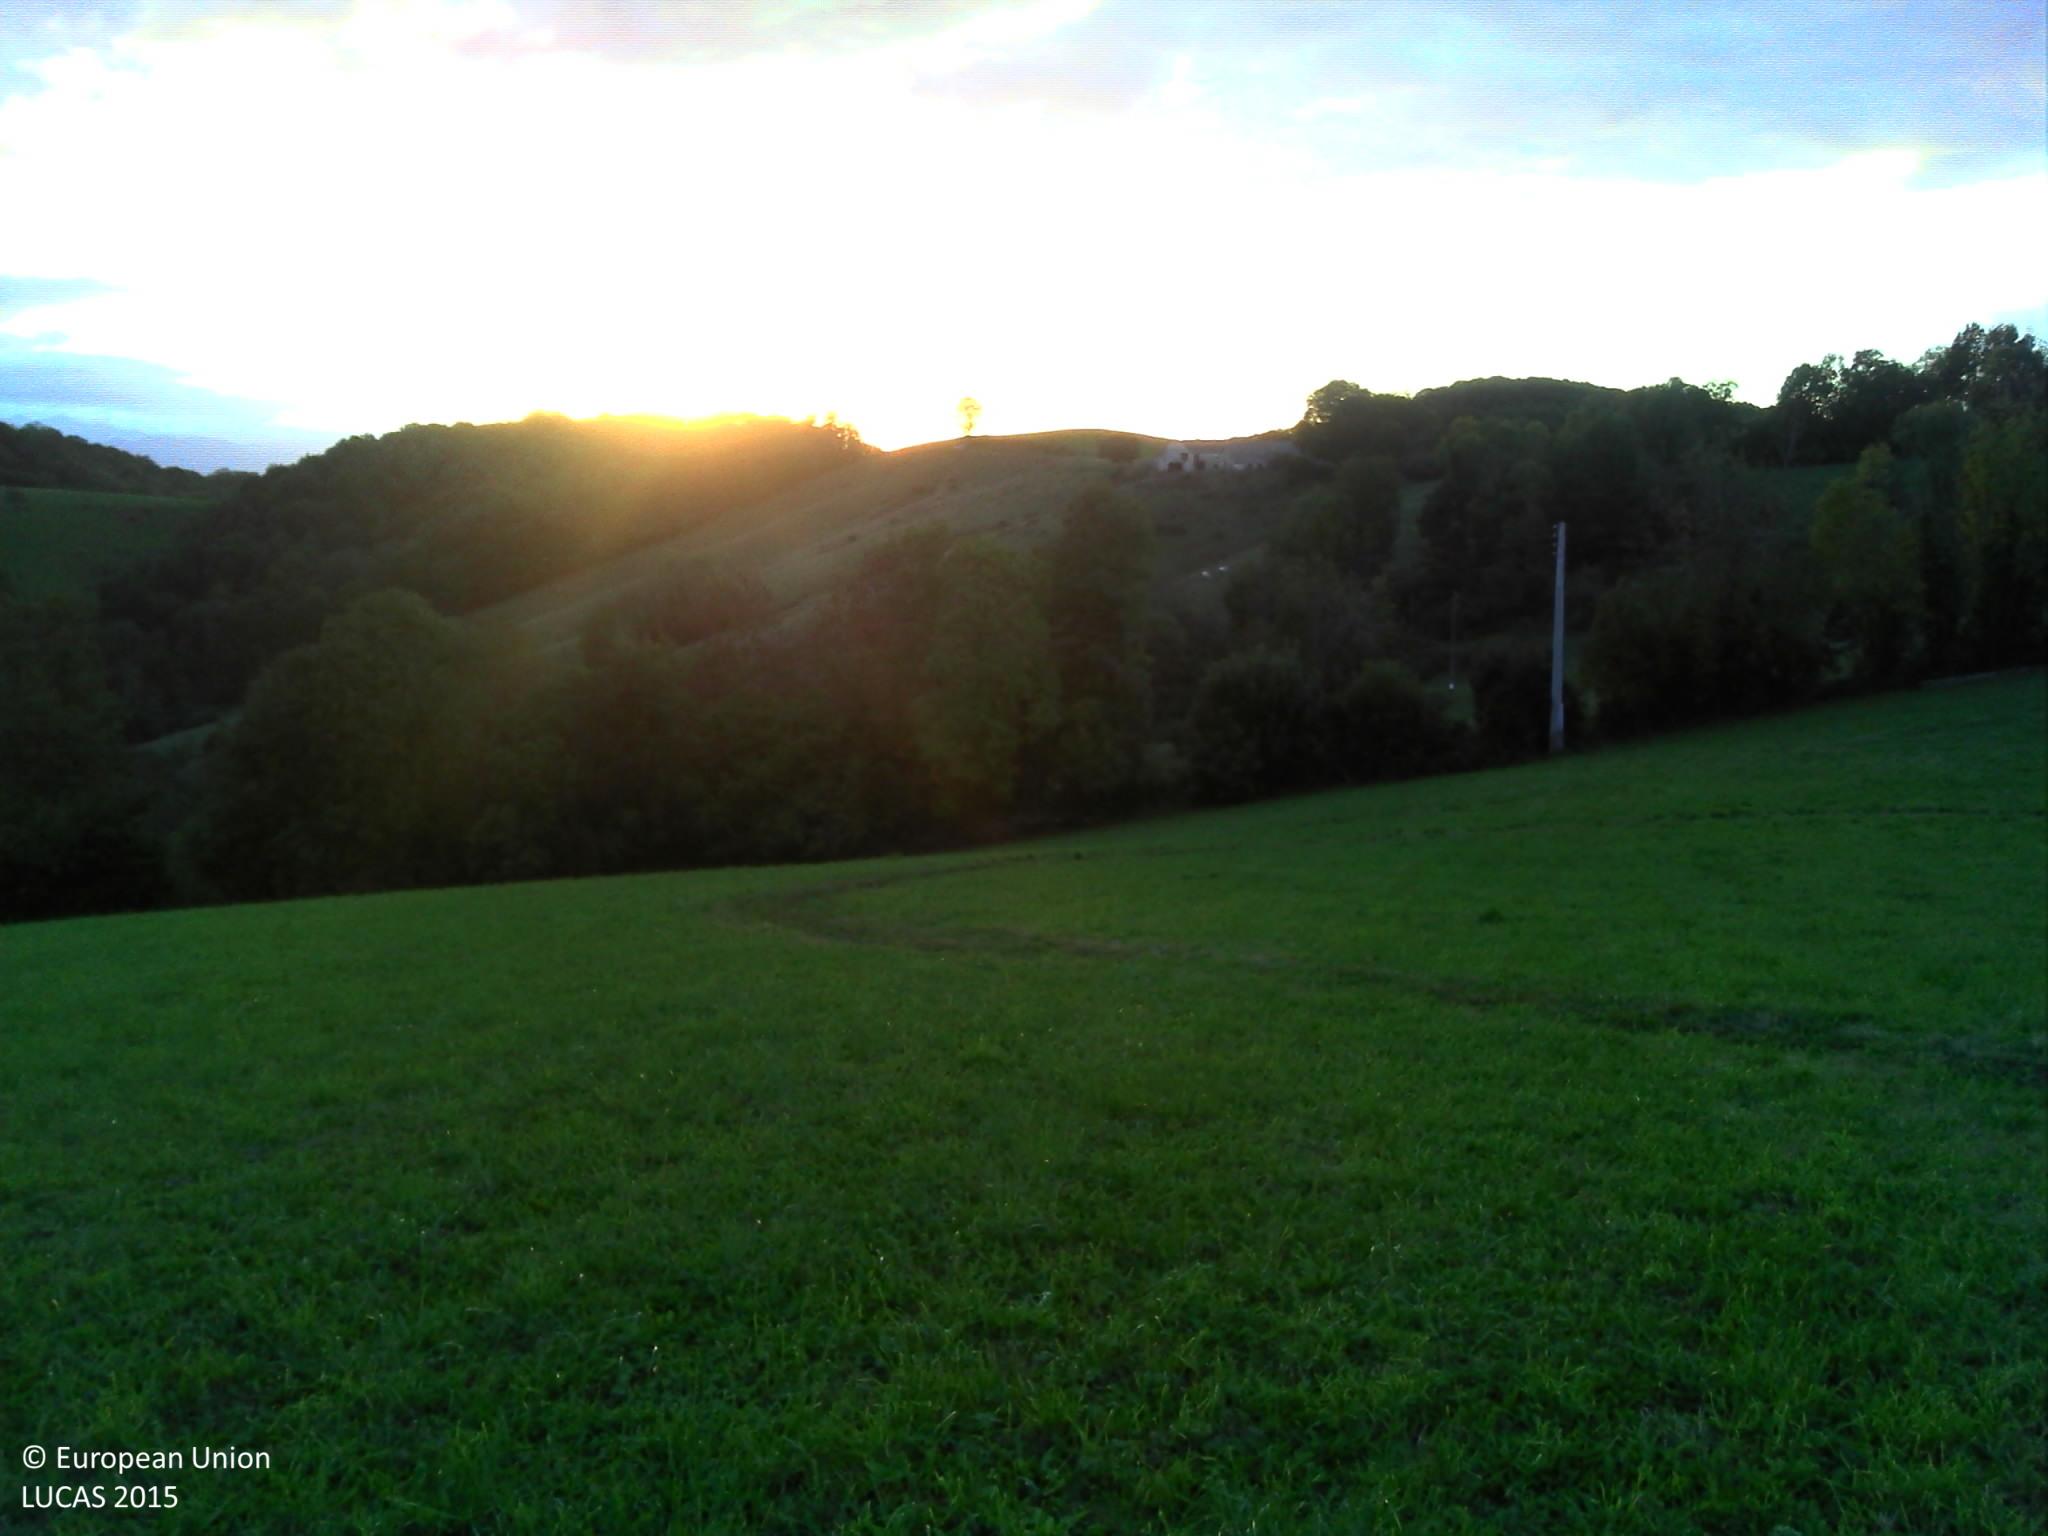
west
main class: Grassland
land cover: Grassland without tree/shrub cover
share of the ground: > 75 %
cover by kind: herbaceous plants 100 %
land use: Agriculture (excluding fallow land and kitchen gardens)
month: September
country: FR
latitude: 43.1432
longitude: -0.1476
